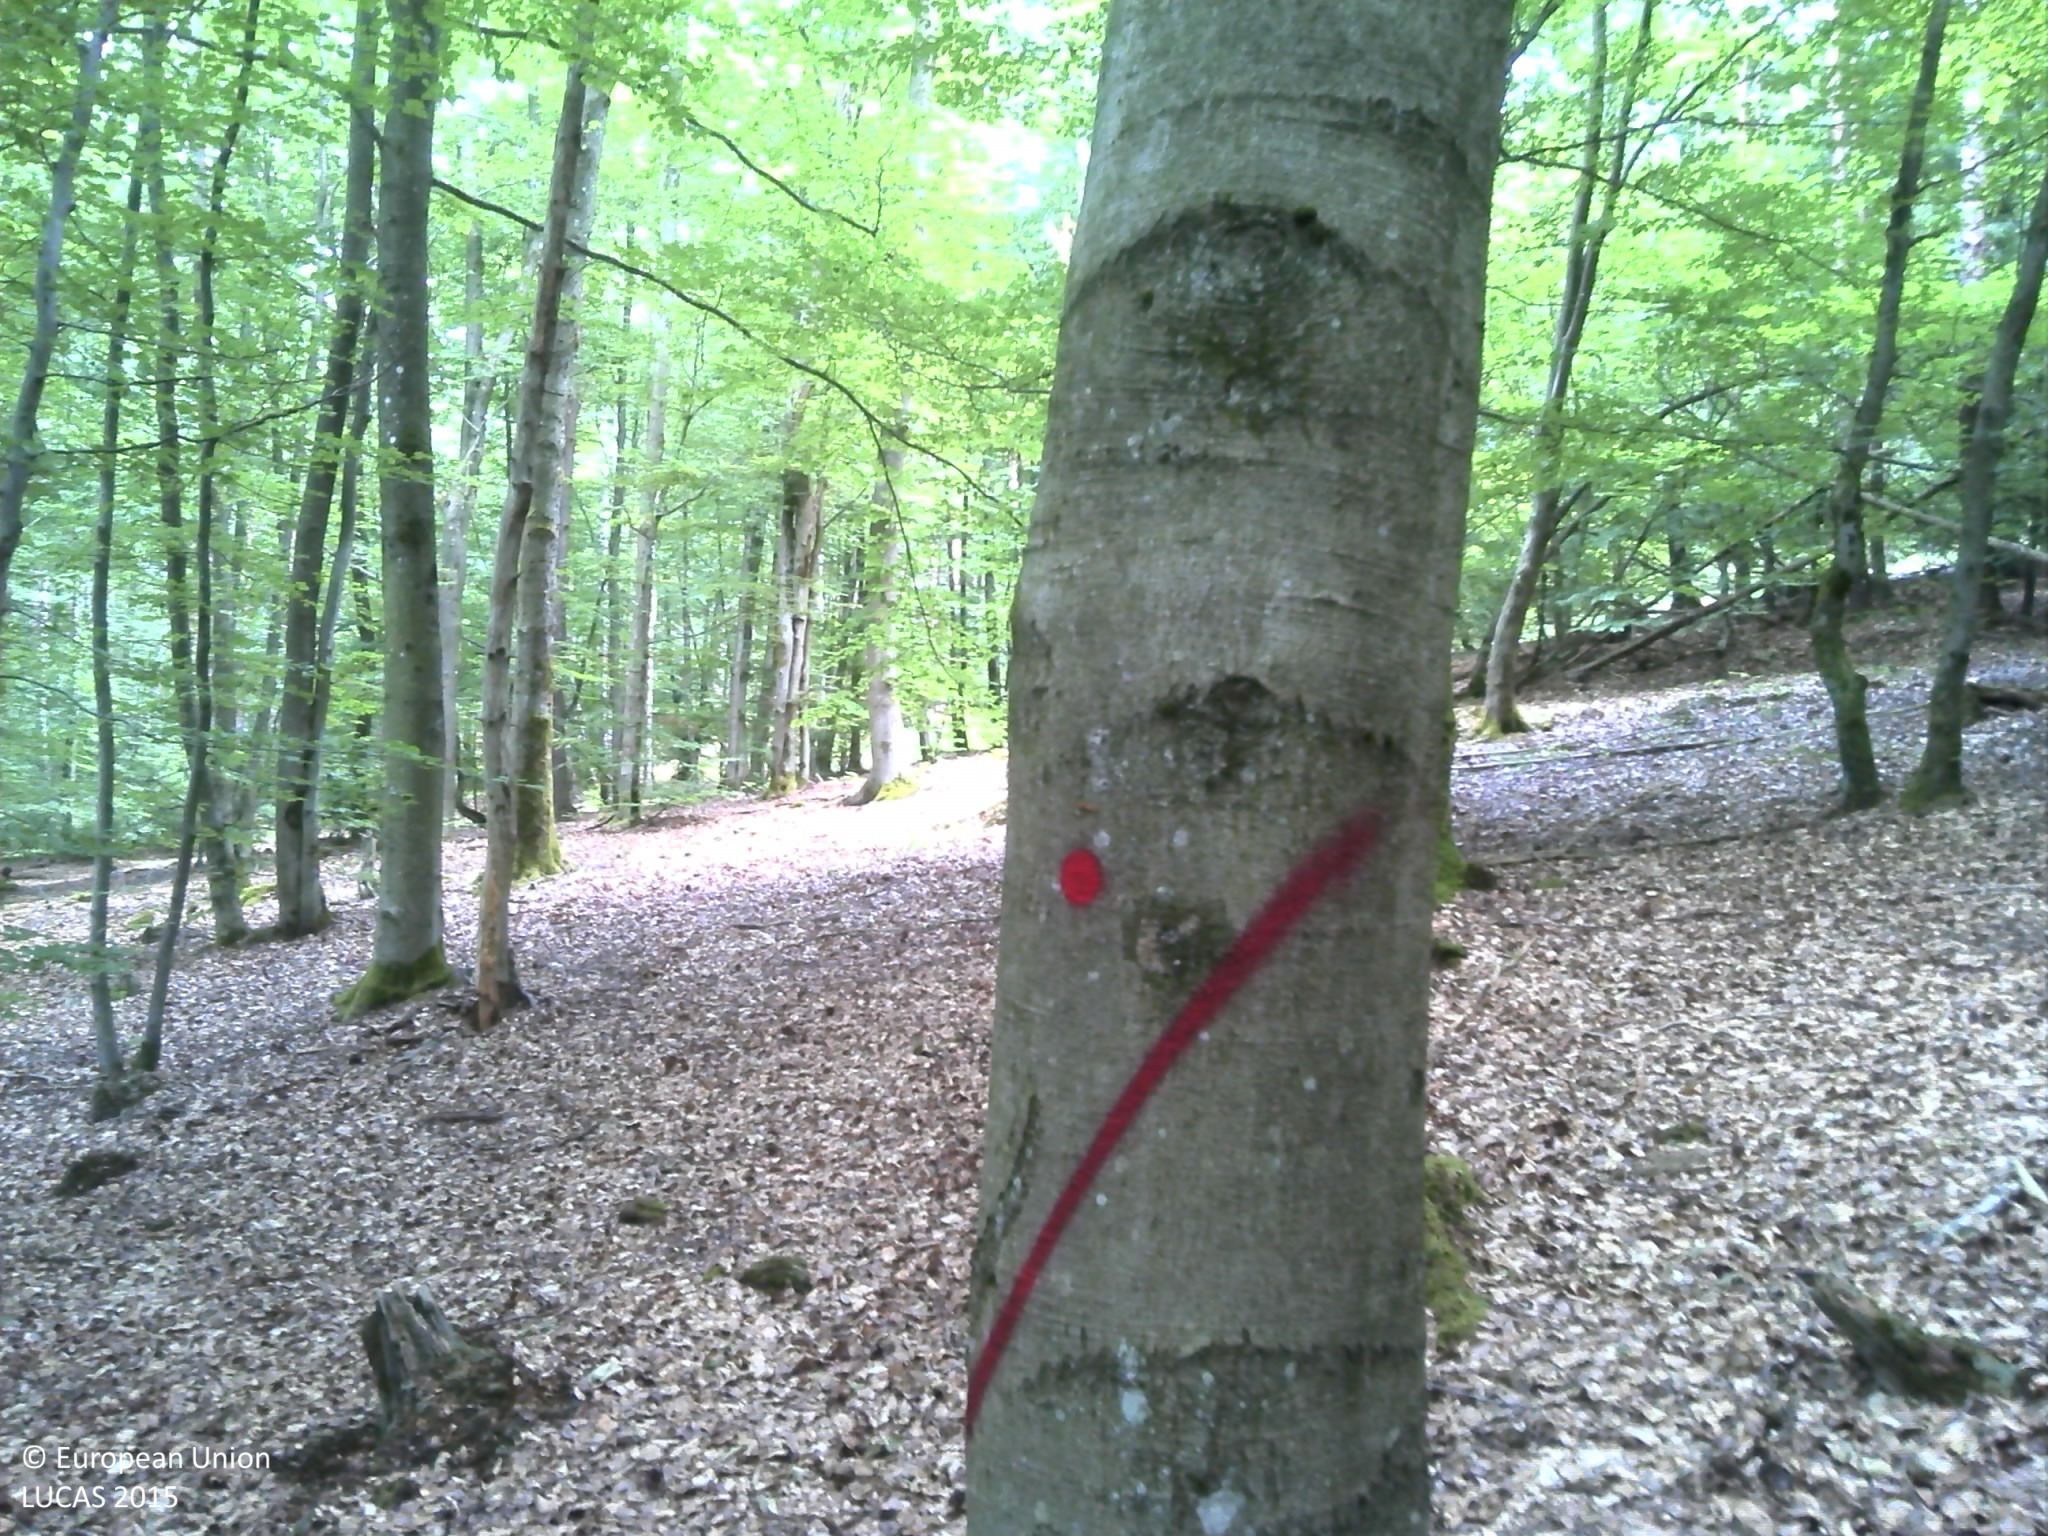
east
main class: Woodland
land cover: Broadleaved woodland
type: beech forest
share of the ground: > 75 %
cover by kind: broadleaved forest trees 95 %, coniferous forest trees 5 %
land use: Forestry
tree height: > 5 m
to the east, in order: Broadleaved woodland; Shrubland without tree cover; Pine dominated mixed woodland; Grassland without tree/shrub cover; Pine dominated mixed woodland
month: July
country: FR
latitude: 49.0957
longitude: 7.5217
